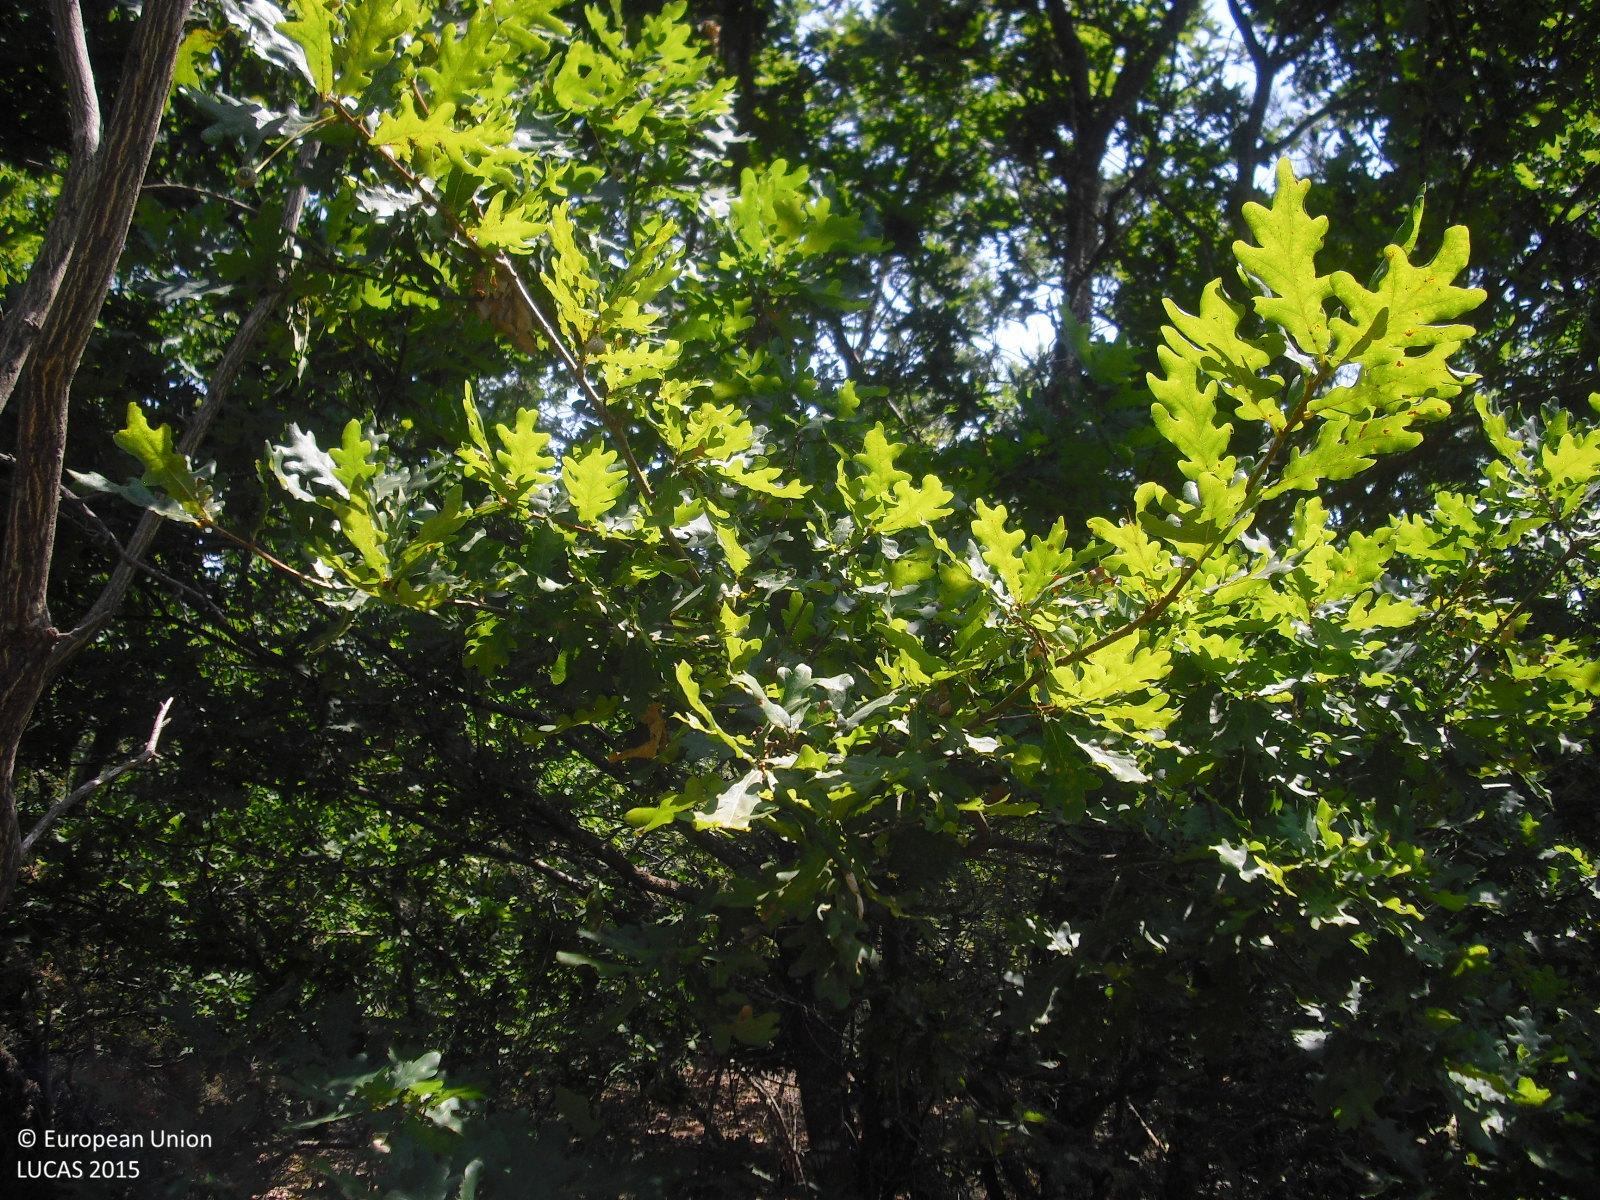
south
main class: Woodland
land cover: Pine dominated mixed woodland
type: hemiboreal forest and nemoral coniferous forest and mixed broadleaved-coniferous forest
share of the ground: 25 - 50 %
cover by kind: shrubs 55 %, coniferous forest trees 30 %, broadleaved forest trees 15 %
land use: Forestry
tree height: > 5 m
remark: Clear cut
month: July
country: ES
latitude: 42.4279
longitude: -7.4853
